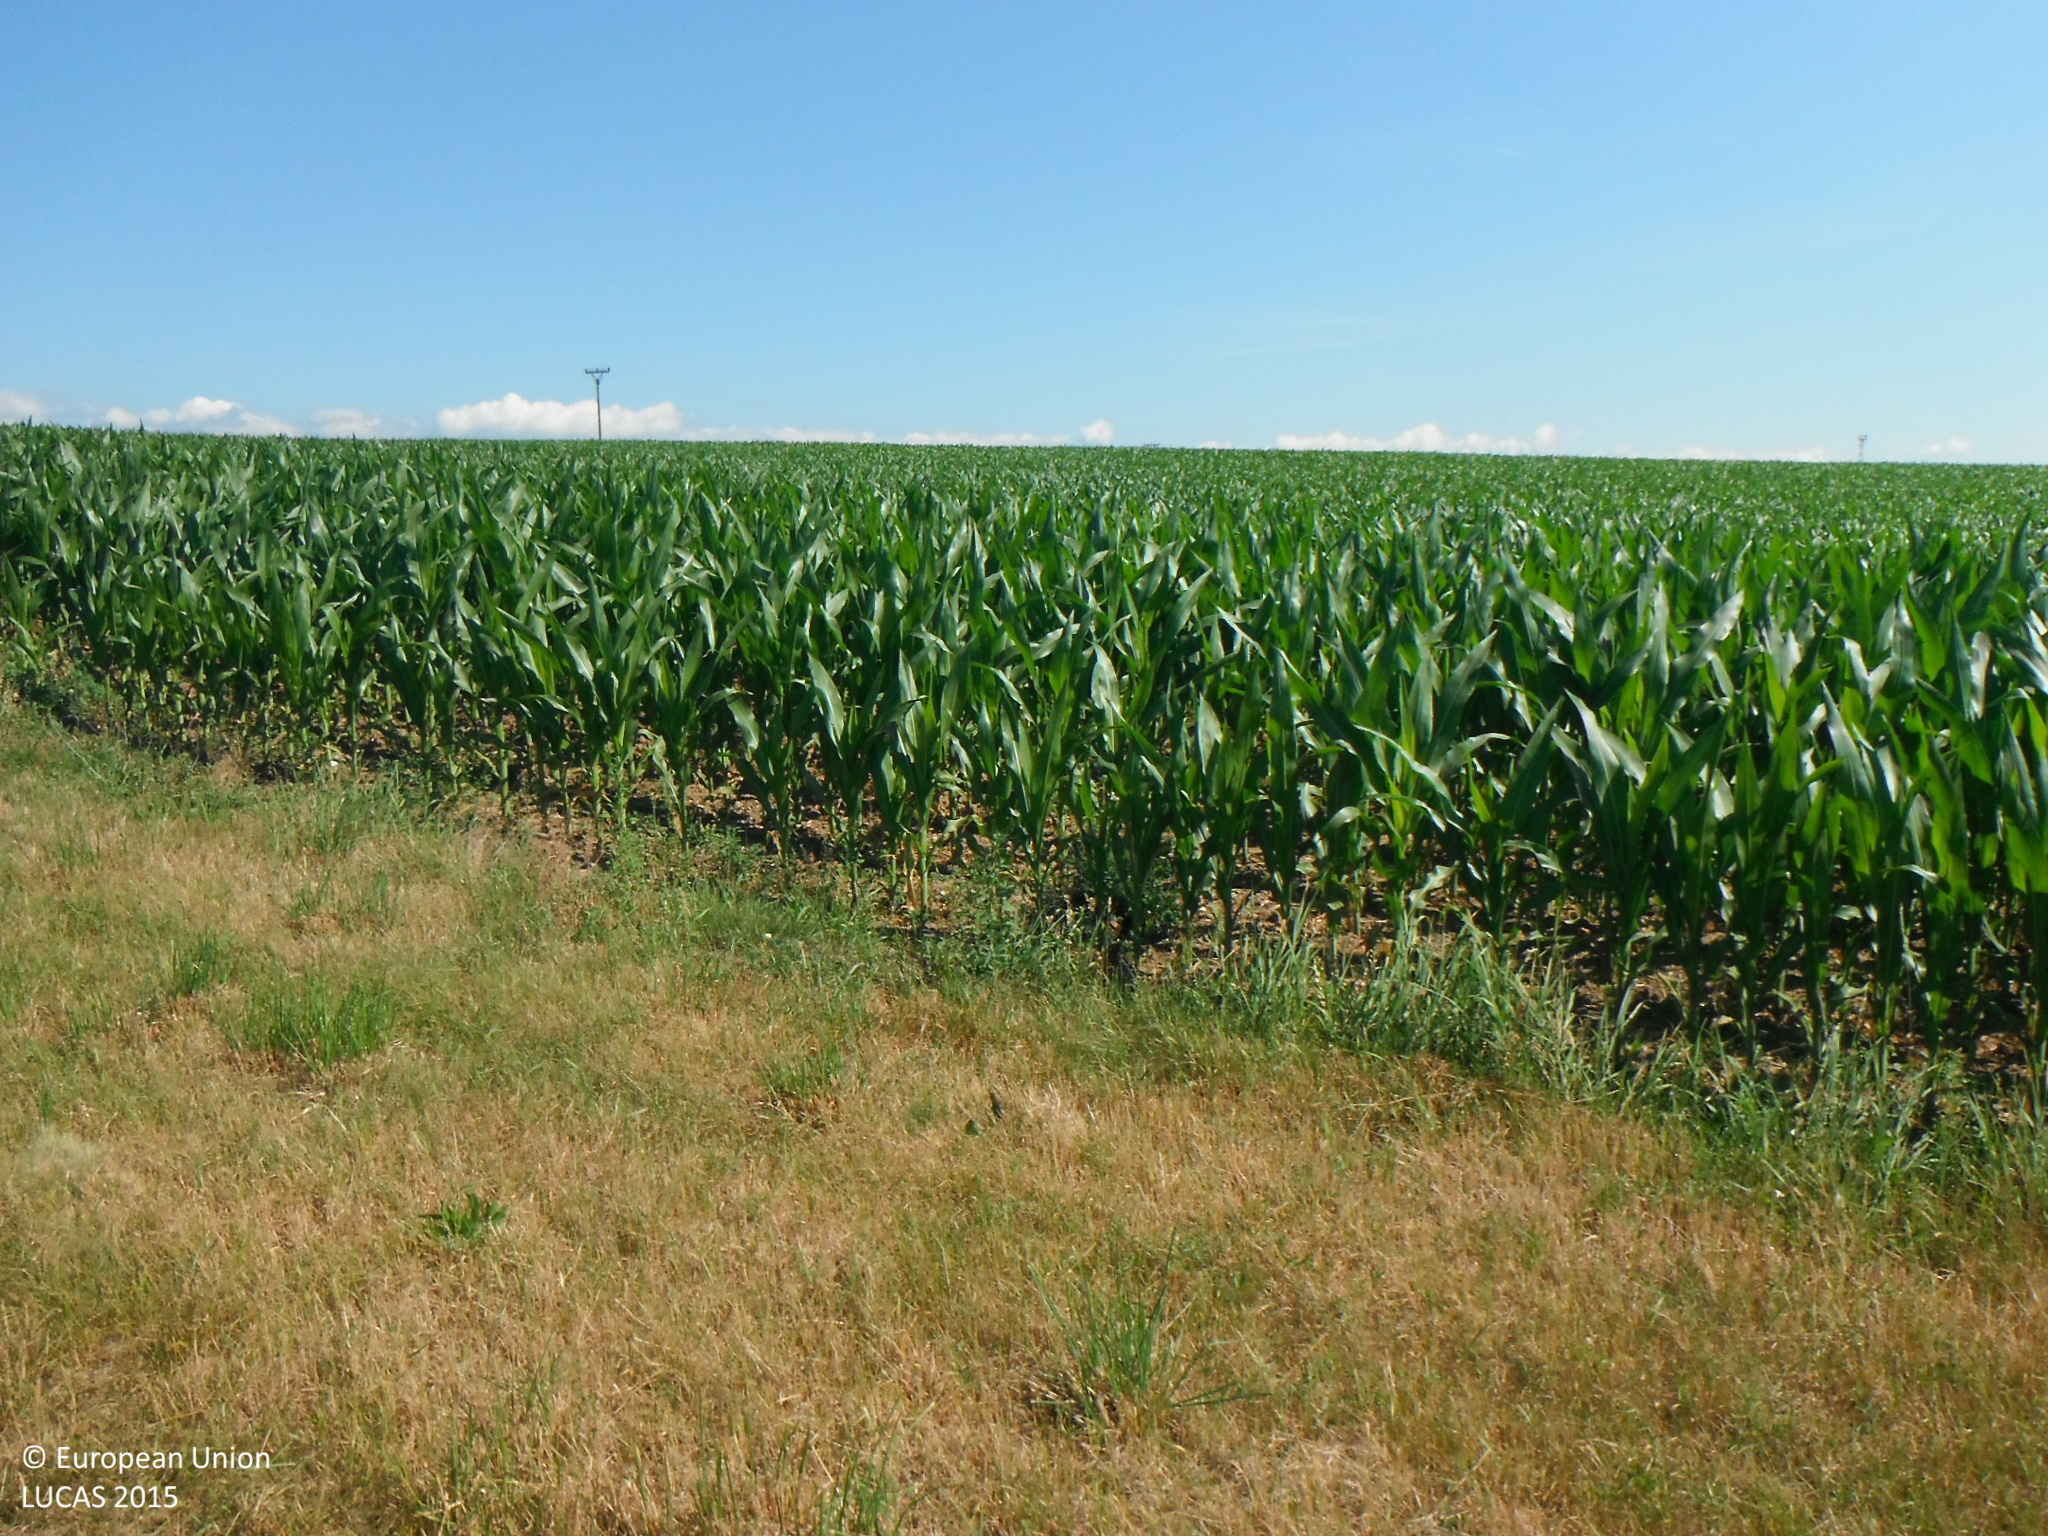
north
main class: Grassland
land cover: Grassland without tree/shrub cover
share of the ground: > 75 %
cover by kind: herbaceous plants 100 %
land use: Agriculture (excluding fallow land and kitchen gardens)
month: June
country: SK
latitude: 48.3623
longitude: 19.8401
